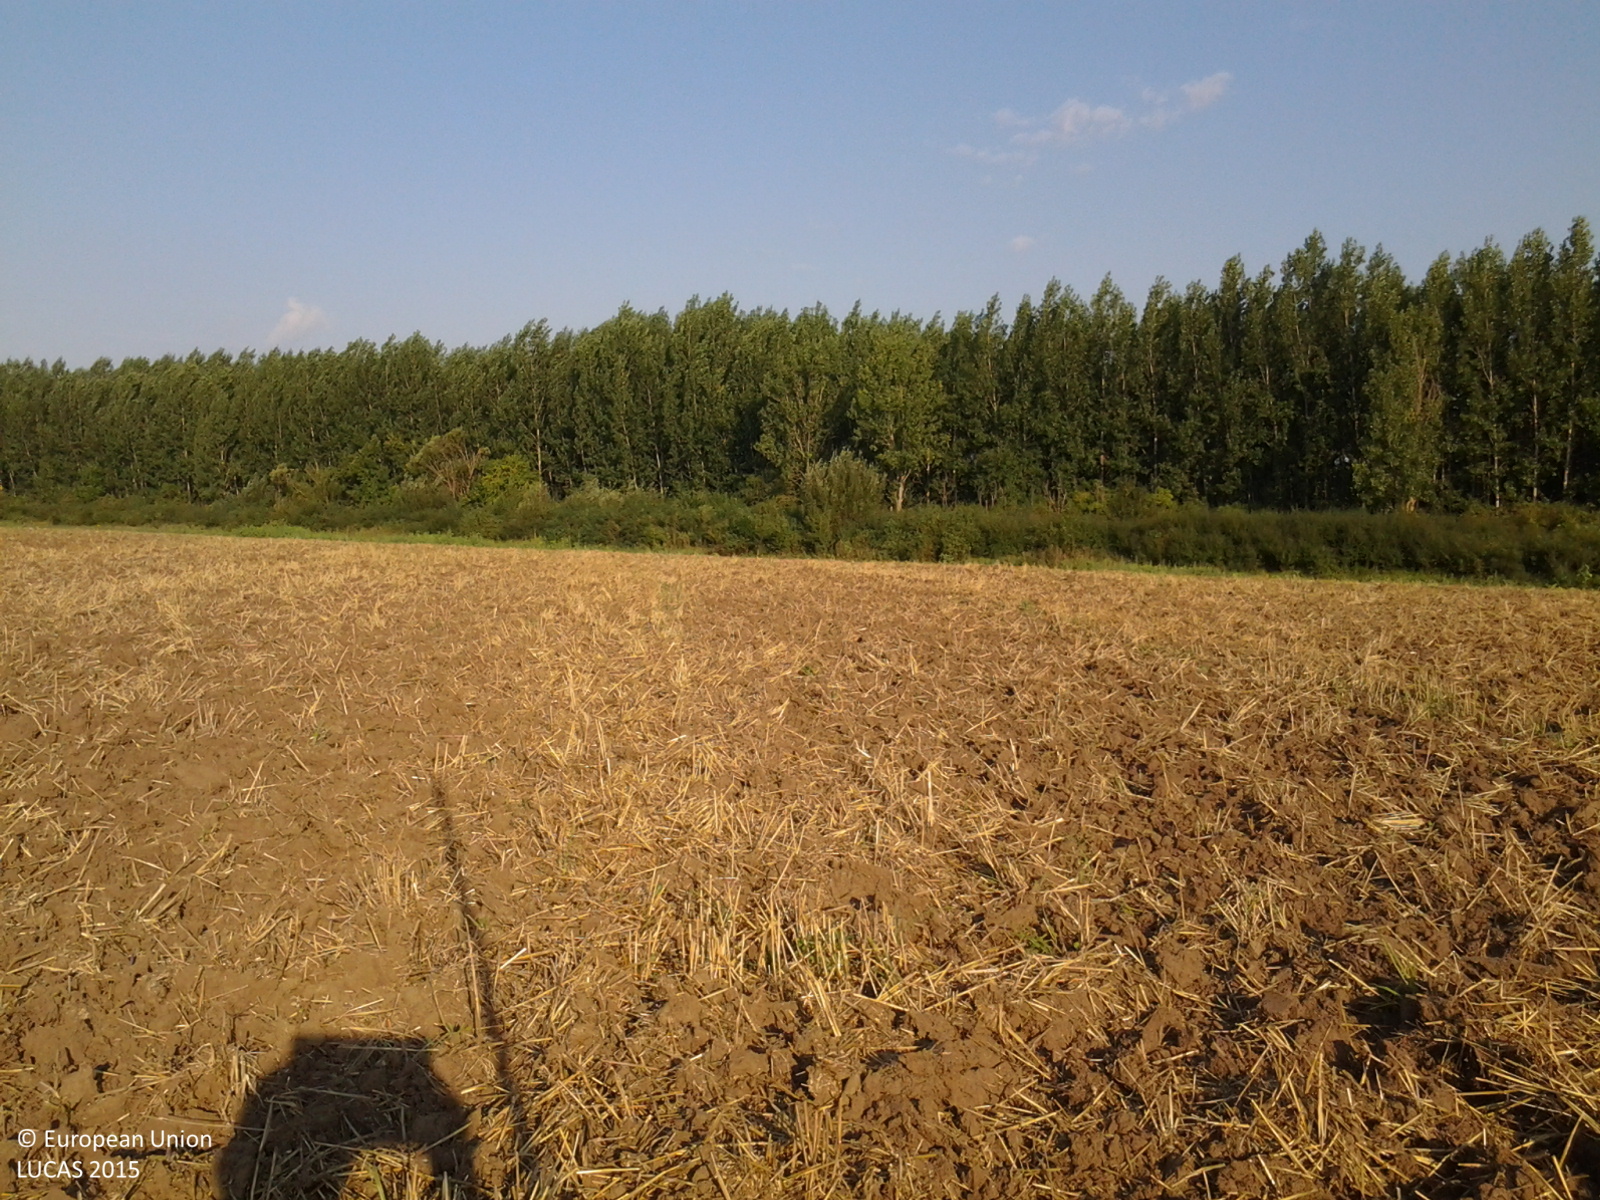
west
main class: Cropland
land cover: Common wheat
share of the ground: < 10 %
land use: Agriculture (excluding fallow land and kitchen gardens)
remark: Harvested field
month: August
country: HU
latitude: 46.9020
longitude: 21.5797
